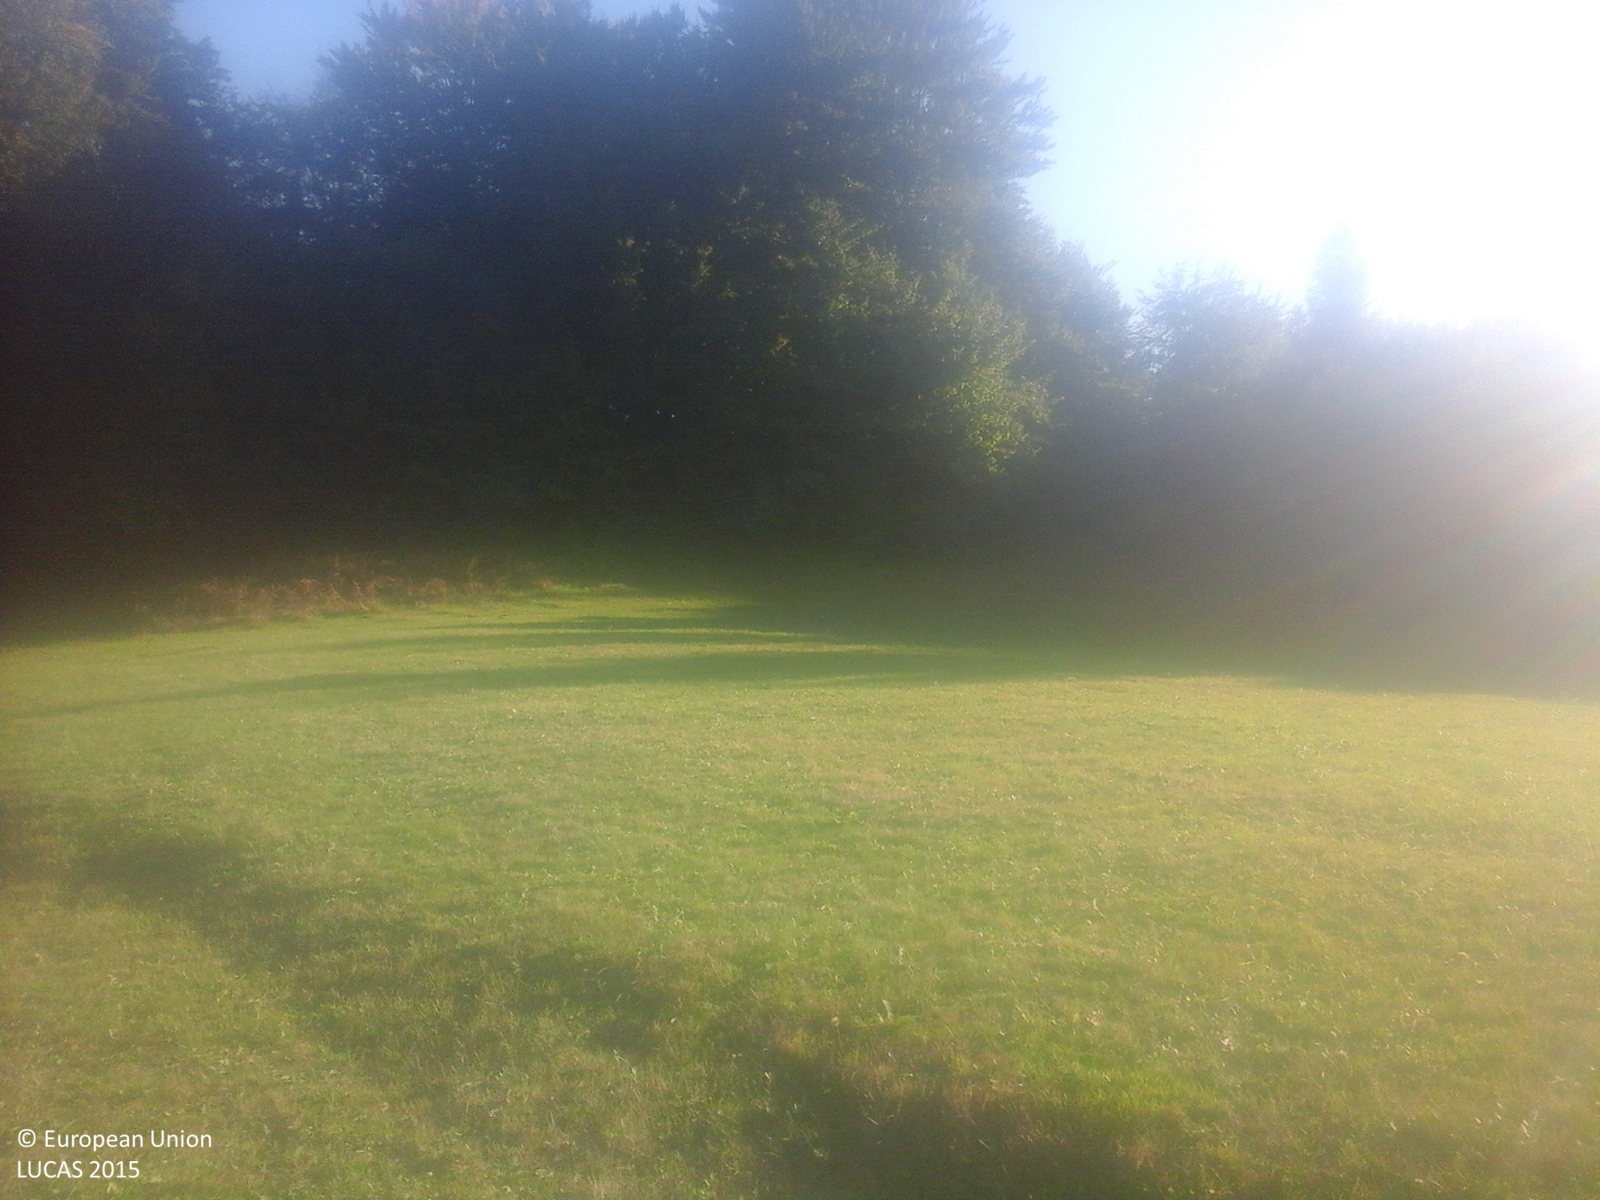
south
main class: Grassland
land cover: Grassland without tree/shrub cover
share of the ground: > 75 %
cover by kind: herbaceous plants 100 %
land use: Agriculture (excluding fallow land and kitchen gardens)
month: October
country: RO
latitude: 46.2355
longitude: 23.0915
